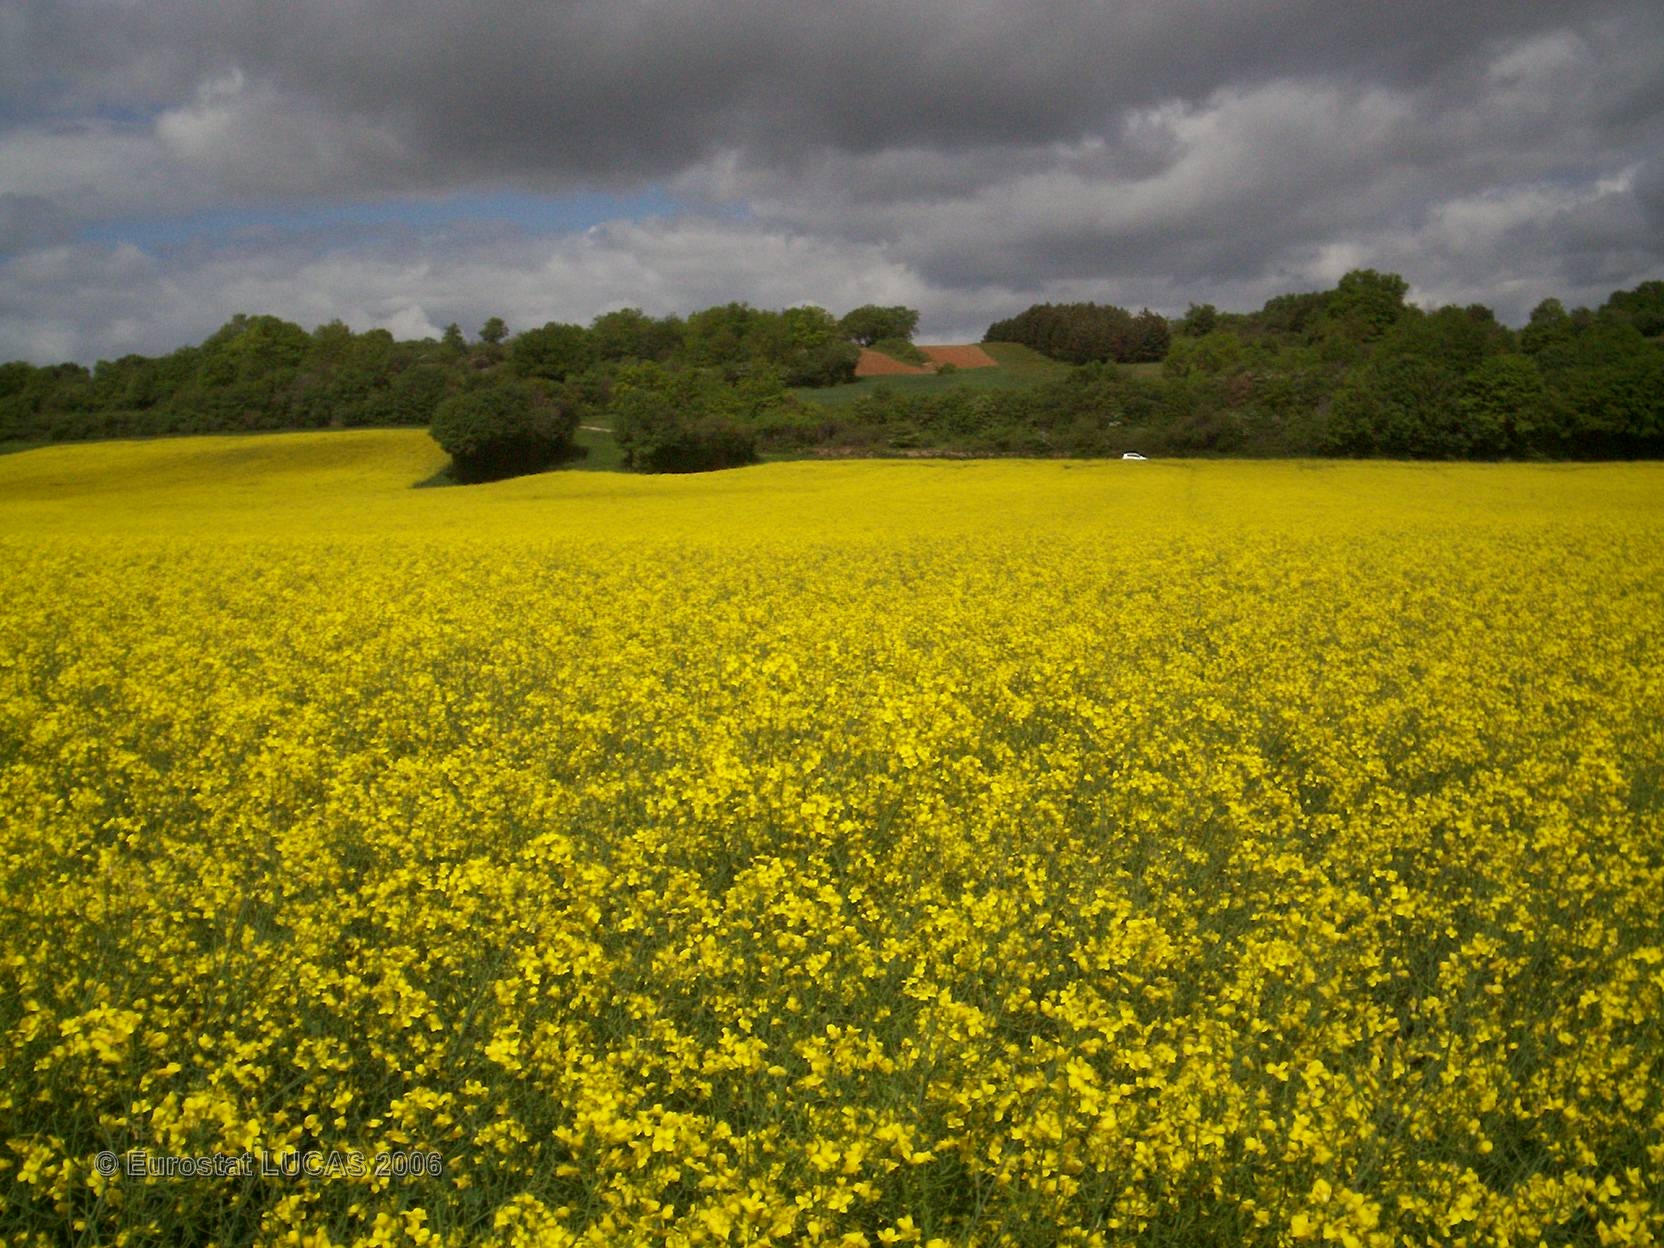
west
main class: Cropland
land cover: Rape and turnip rape
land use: Agriculture (excluding fallow land and kitchen gardens)
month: May
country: FR
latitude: 47.0664
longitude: 4.6676
